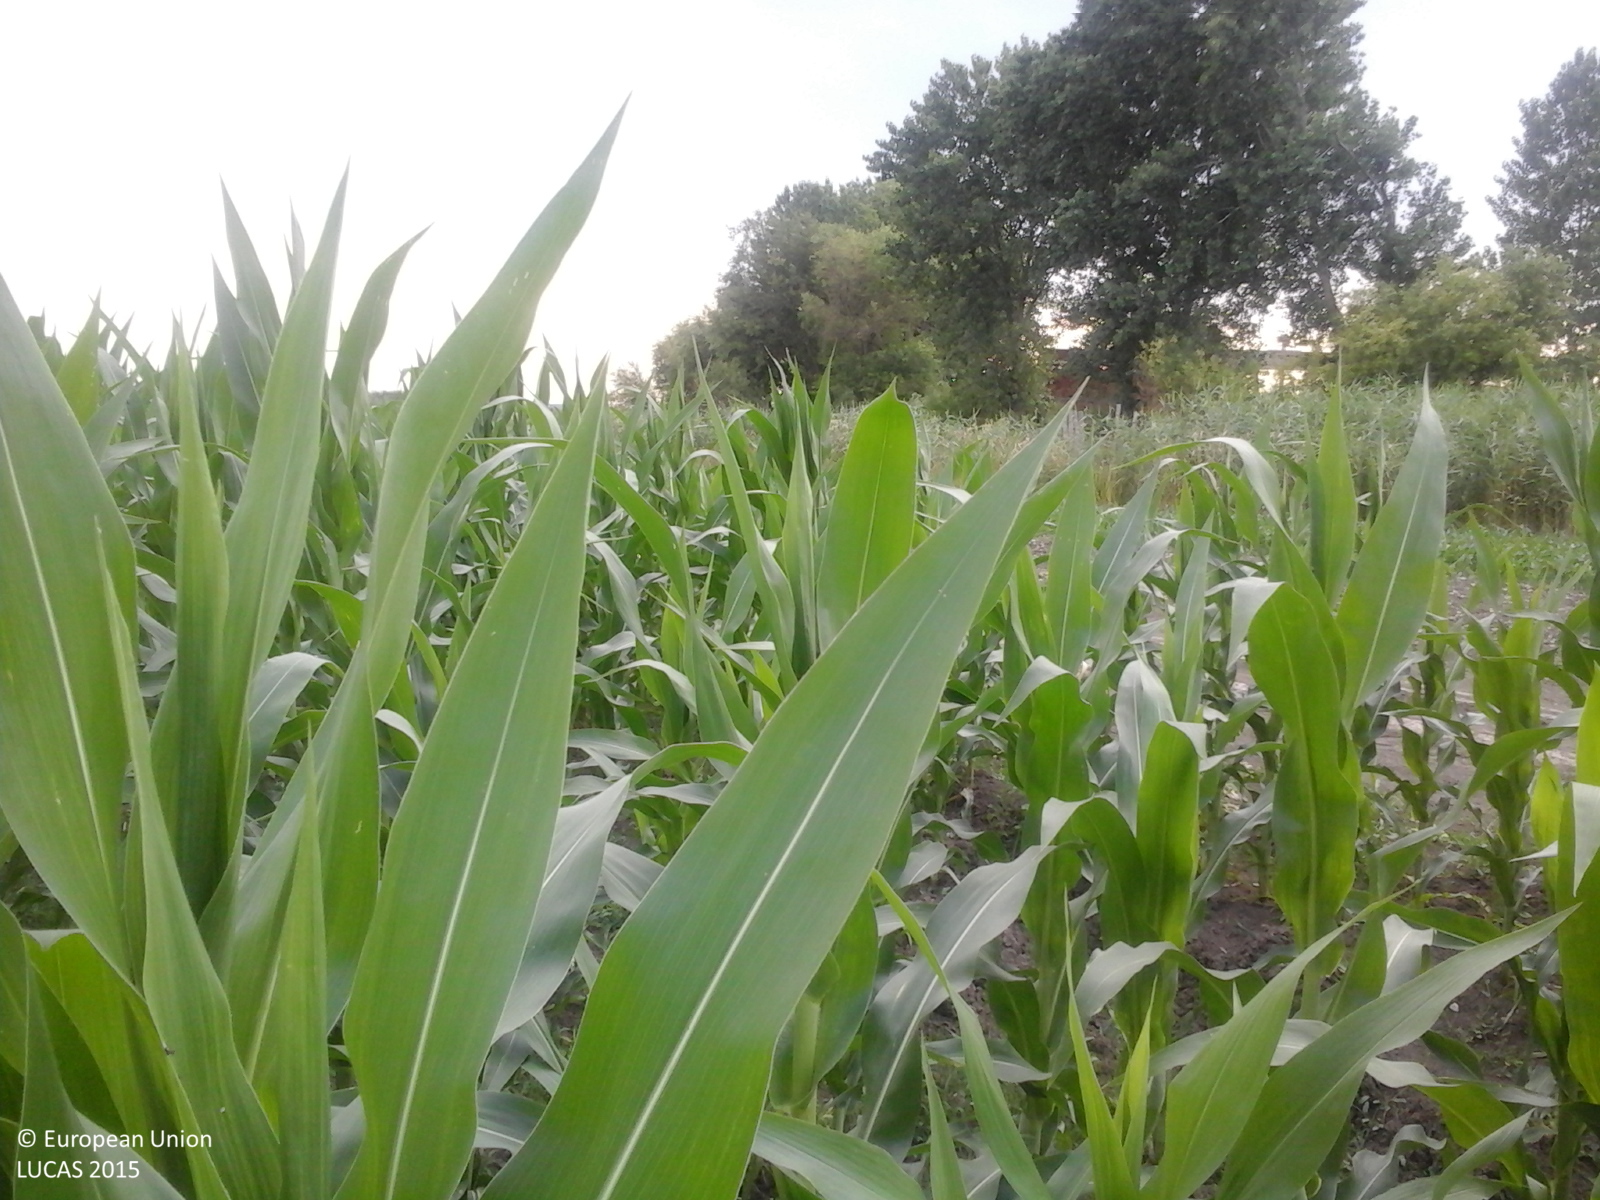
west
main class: Cropland
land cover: Maize
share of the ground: > 75 %
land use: Agriculture (excluding fallow land and kitchen gardens)
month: June
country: RO
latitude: 44.0211
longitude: 26.2090
